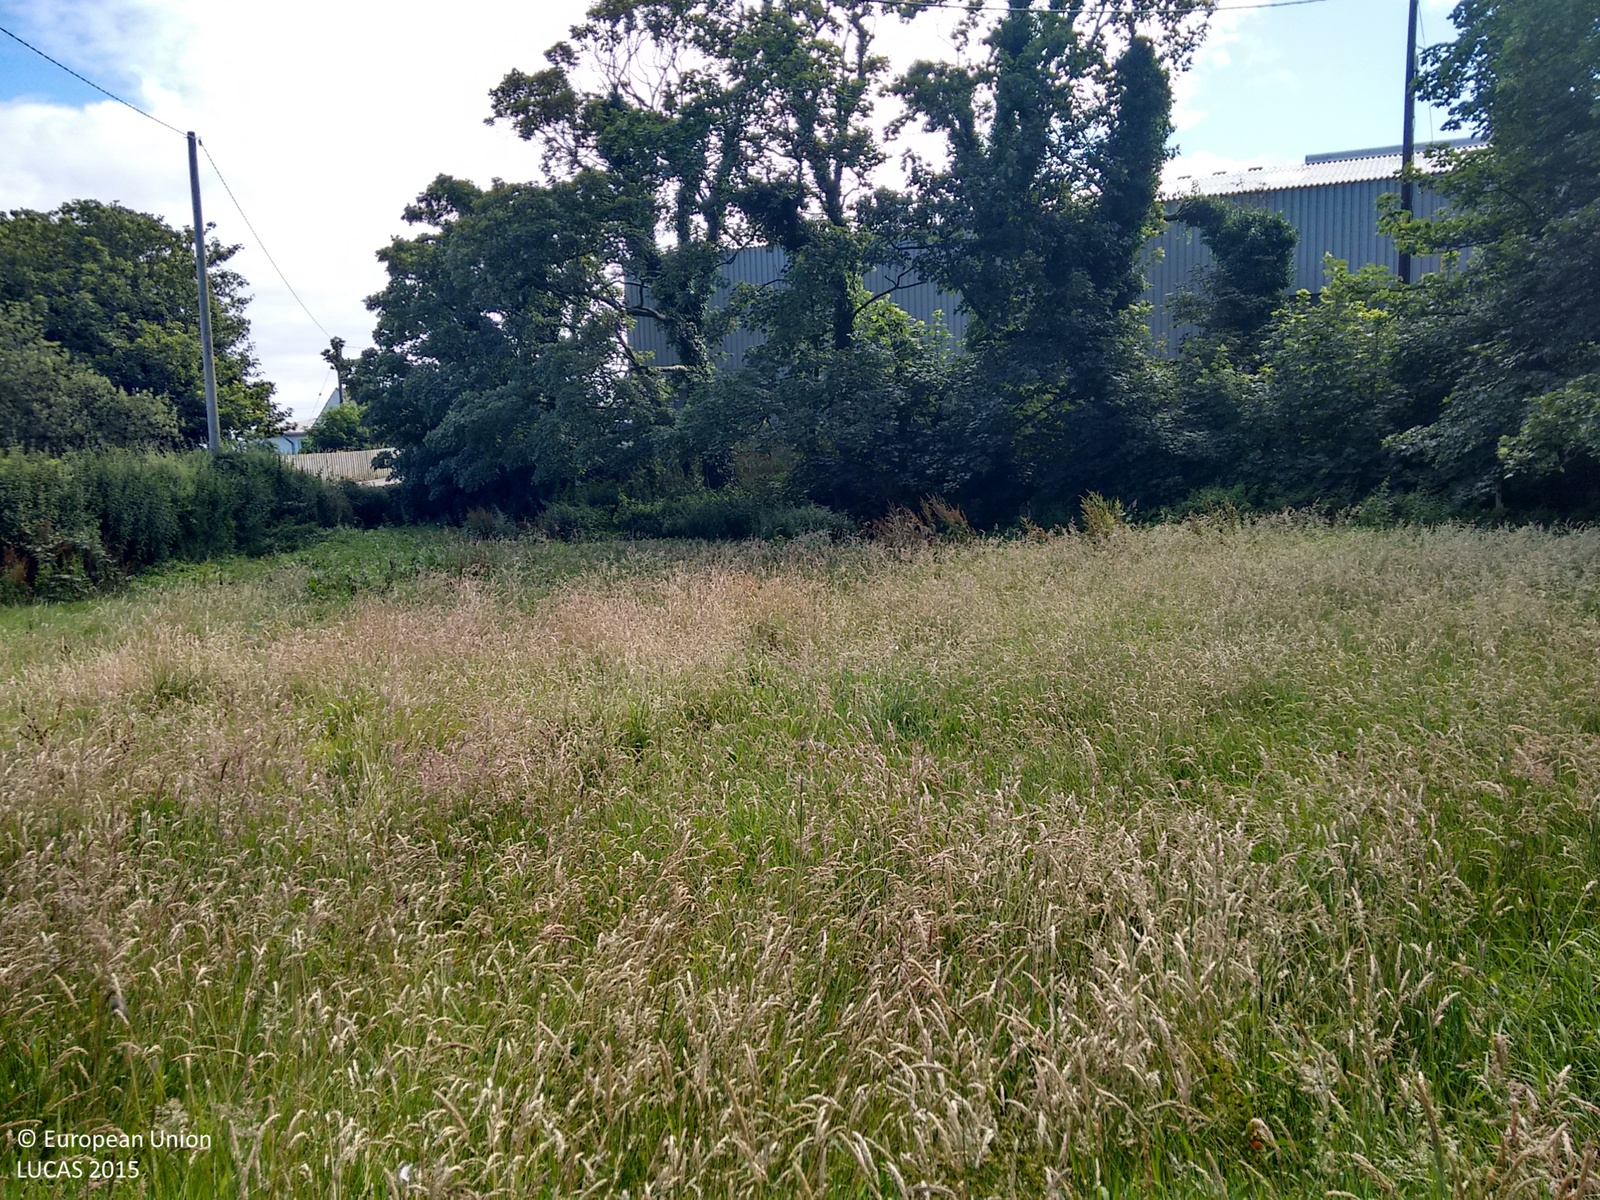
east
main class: Grassland
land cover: Grassland with sparse tree/shrub cover
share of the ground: > 75 %
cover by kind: herbaceous plants 95 %, broadleaved forest trees 5 %
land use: Agriculture (excluding fallow land and kitchen gardens)
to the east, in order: Grassland with sparse tree/shrub cover; Artificial constructions in urban areas; Lines of trees; Grassland without tree/shrub cover; Fences; Grassland without tree/shrub cover
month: August
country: GB
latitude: 54.6885
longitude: -4.8956
